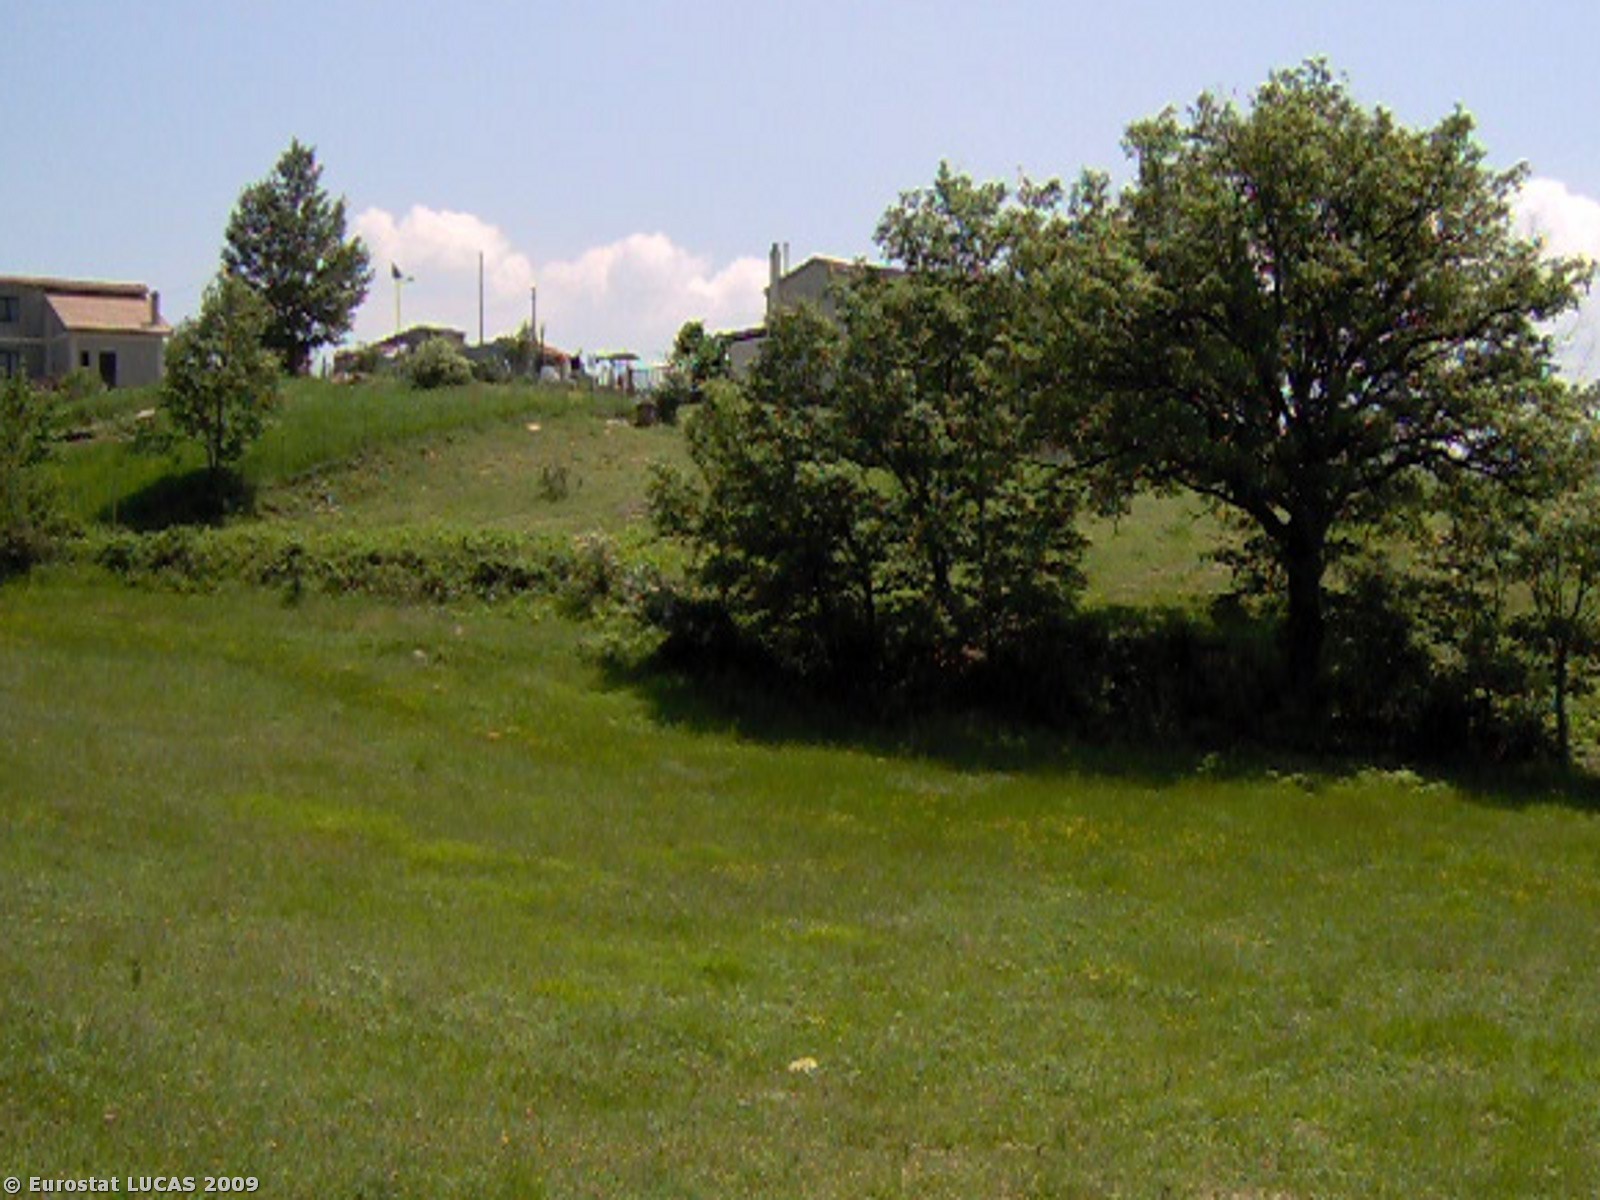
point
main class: Cropland
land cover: Mixed cereals for fodder
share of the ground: > 75 %
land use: Agriculture (excluding fallow land and kitchen gardens)
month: May
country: IT
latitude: 40.5808
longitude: 15.5658
